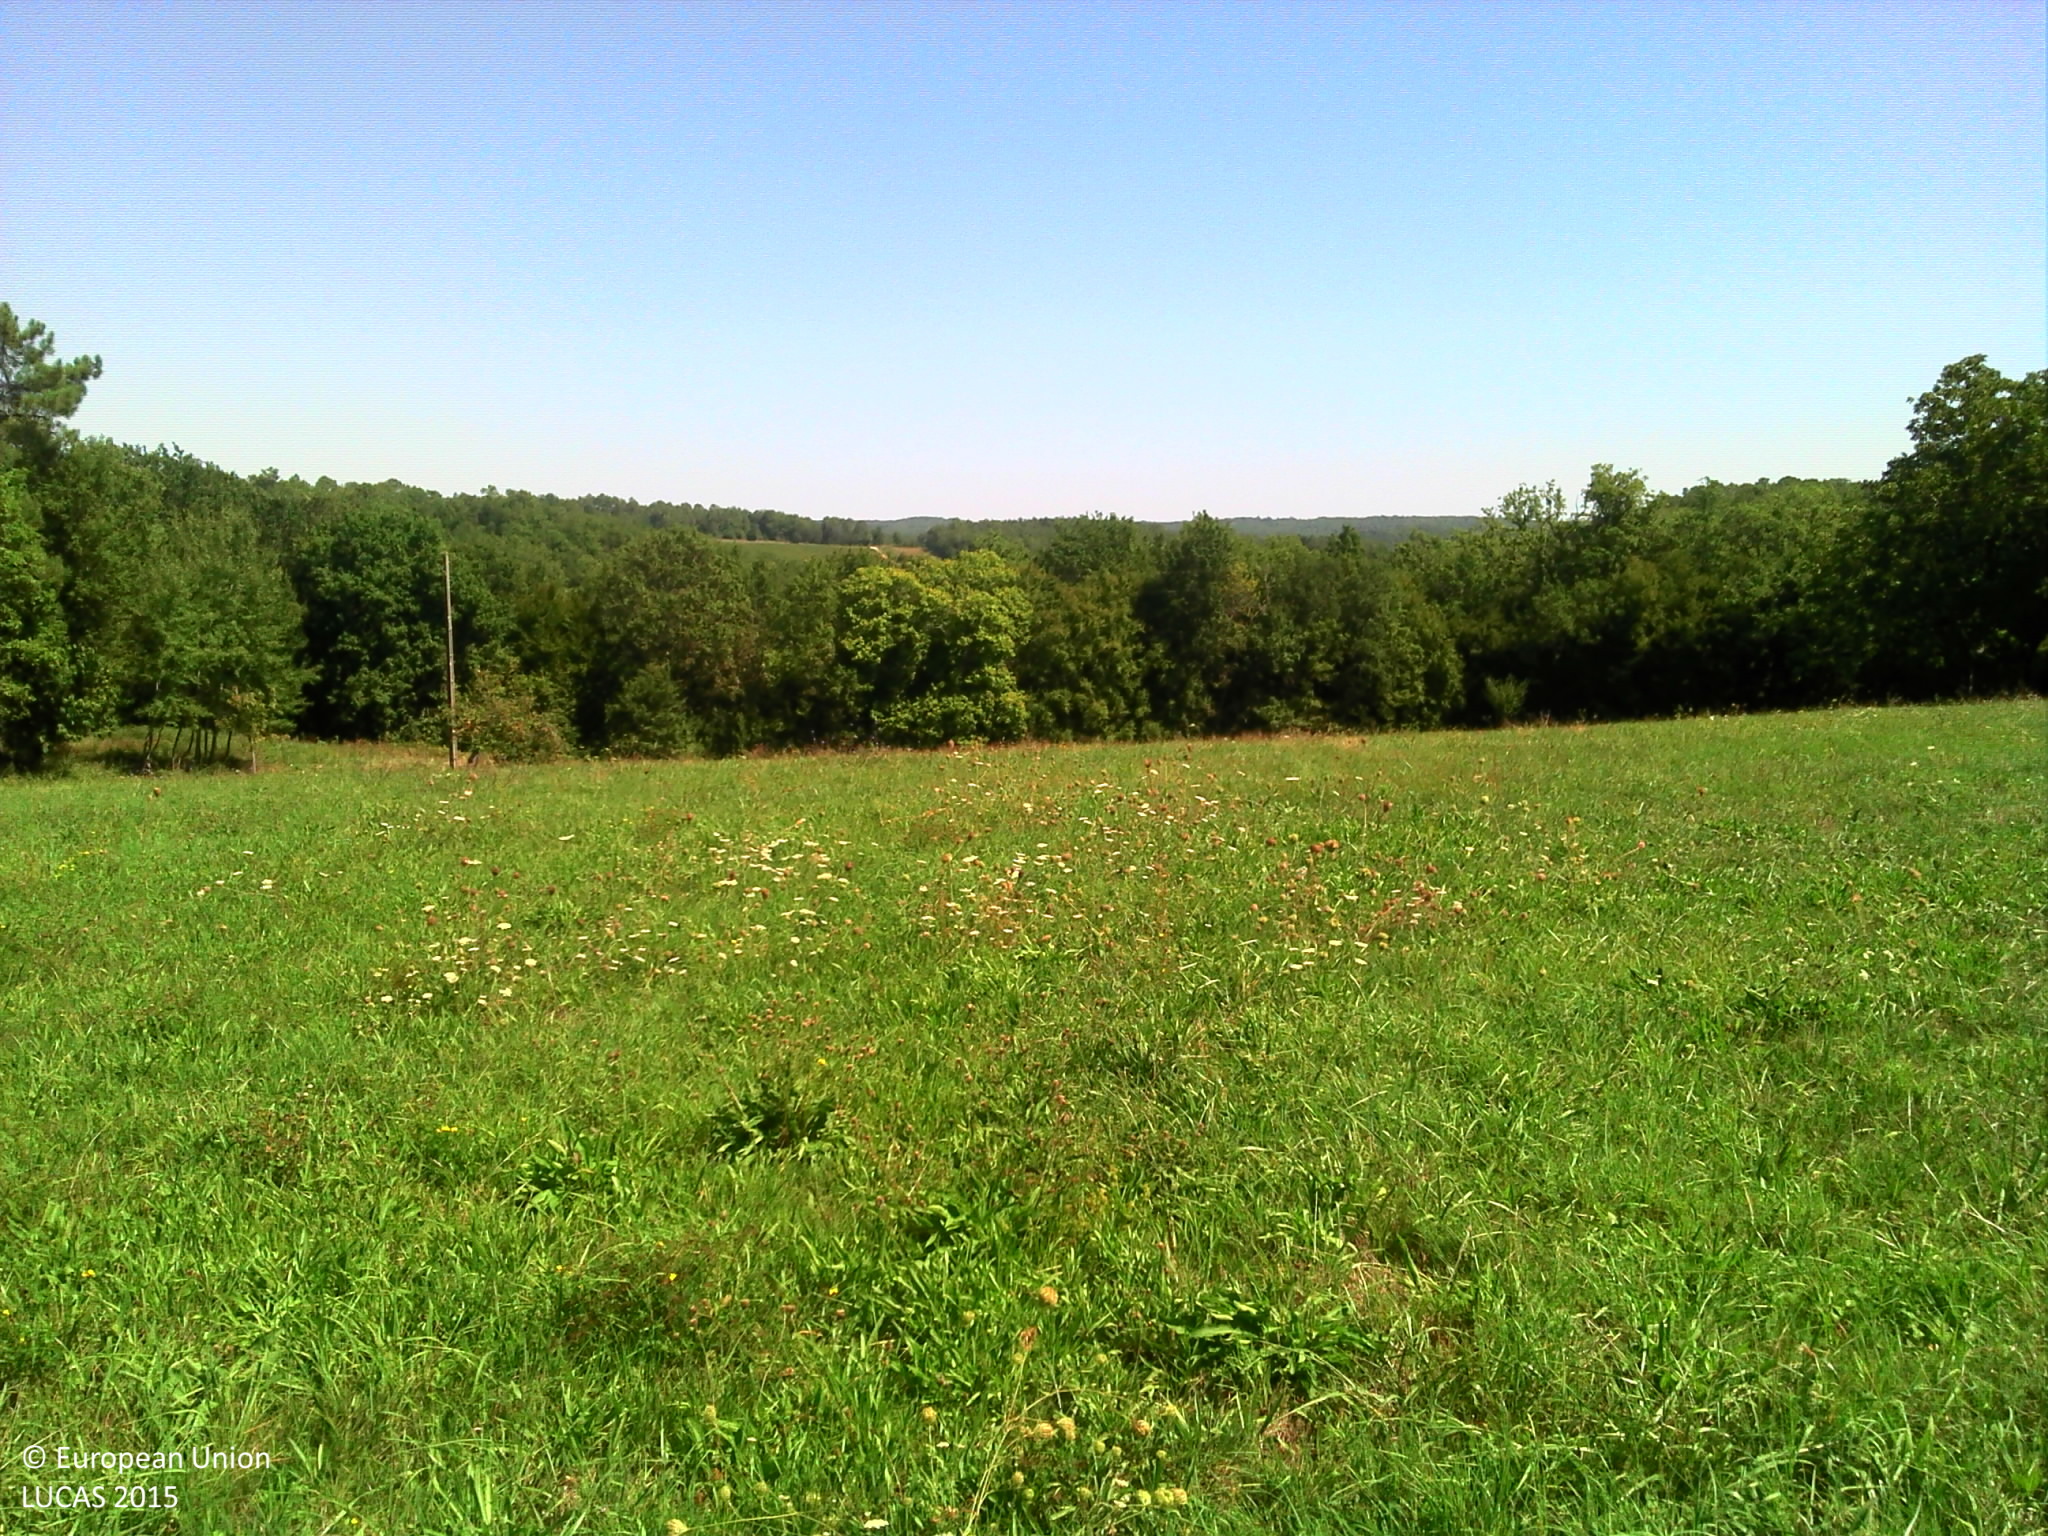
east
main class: Grassland
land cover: Grassland without tree/shrub cover
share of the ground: > 75 %
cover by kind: herbaceous plants 100 %
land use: Agriculture (excluding fallow land and kitchen gardens)
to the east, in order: Grassland without tree/shrub cover; Broadleaved woodland; Tracks; Broadleaved woodland; Grassland without tree/shrub cover; Abandoned hedges; Tracks; Broadleaved woodland
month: August
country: FR
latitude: 44.5739
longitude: 1.1937
